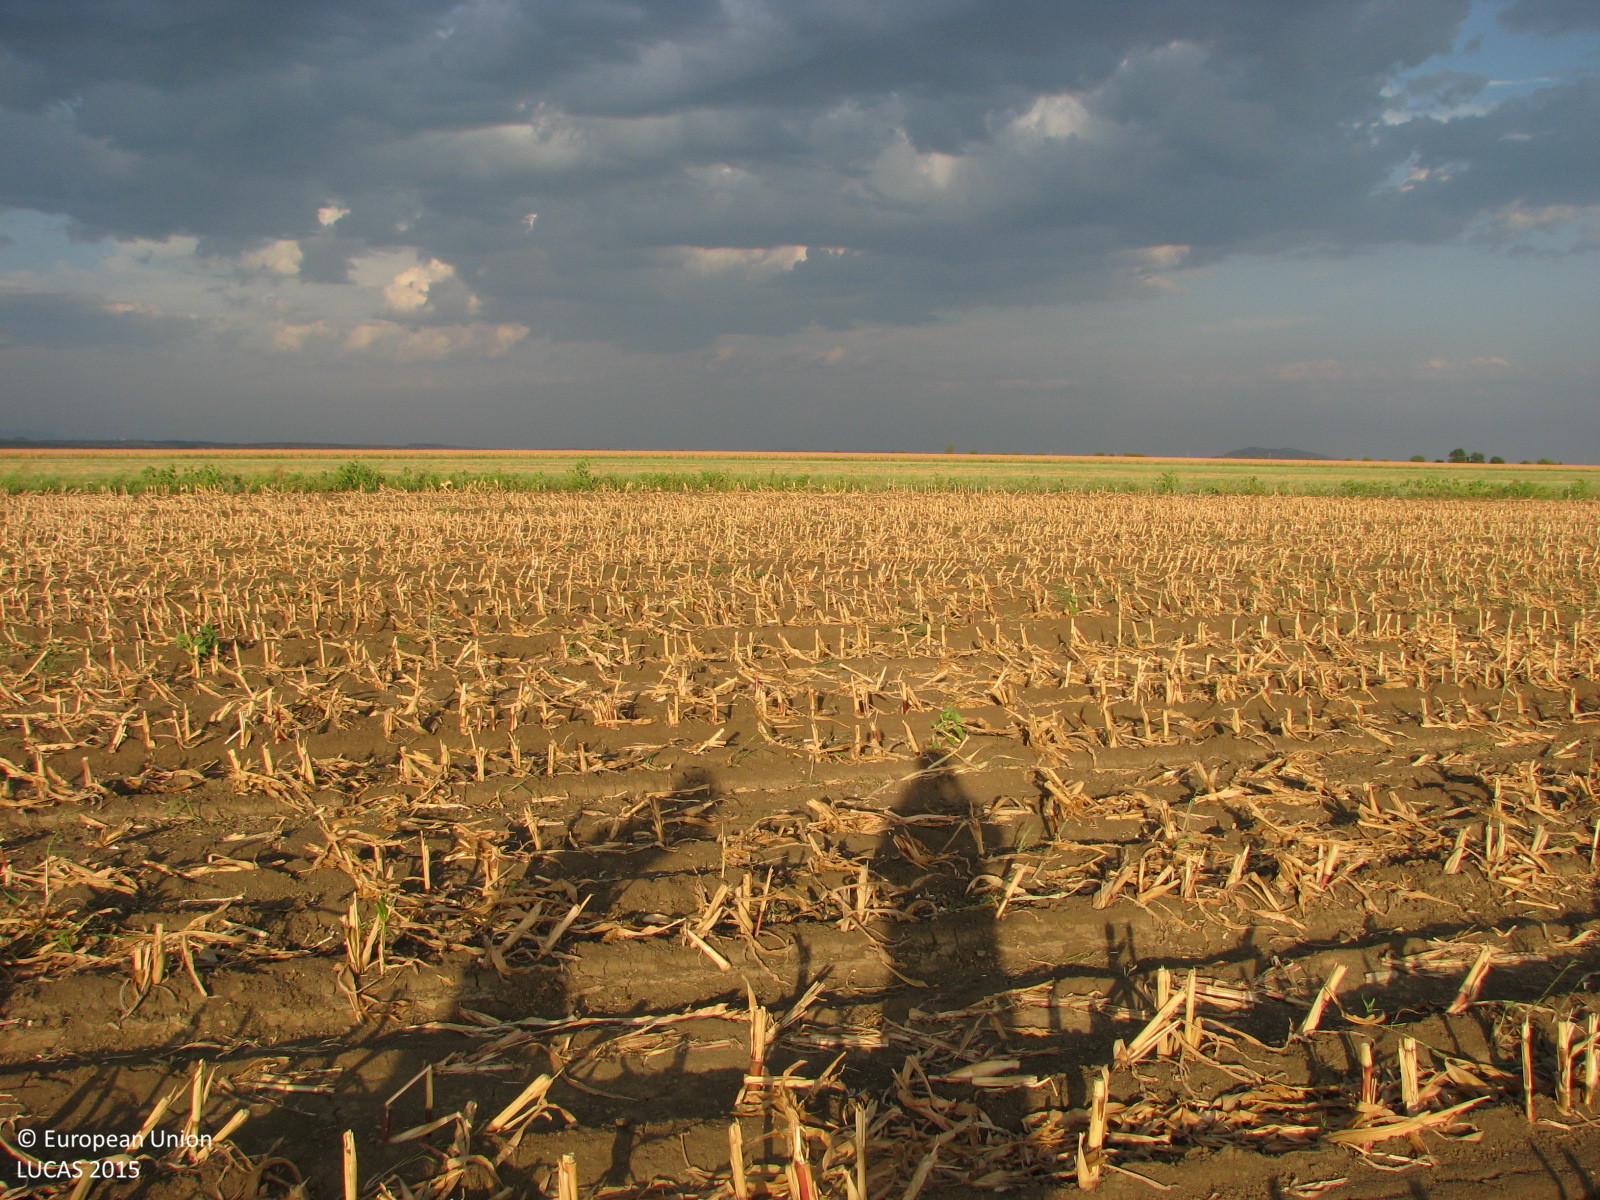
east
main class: Cropland
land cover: Maize
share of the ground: 25 - 50 %
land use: Agriculture (excluding fallow land and kitchen gardens)
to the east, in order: Maize; Grass margins; Common wheat
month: September
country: BG
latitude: 42.5234
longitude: 26.0409
